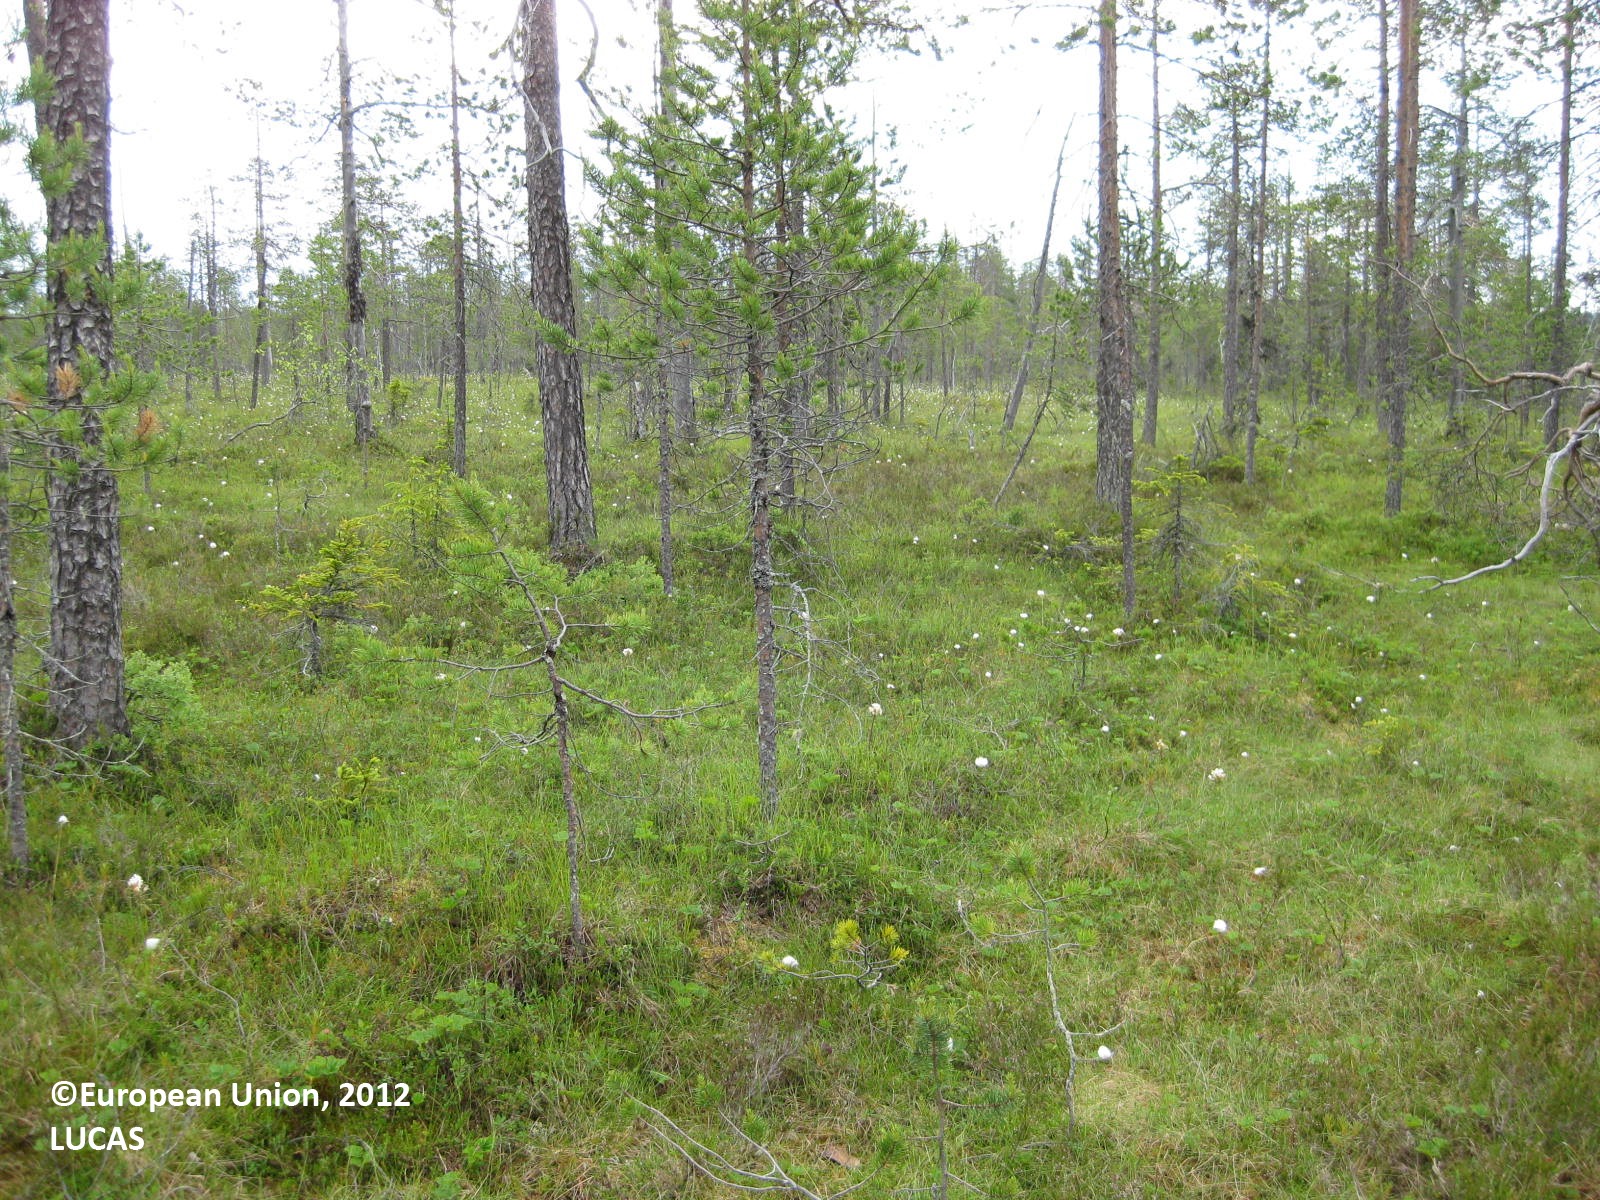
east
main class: Woodland
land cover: Pine dominated coniferous woodland
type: mire and swamp forests
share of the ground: 25 - 50 %
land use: Semi-natural and natural areas not in use
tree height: > 5 m
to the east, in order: Pine dominated coniferous woodland
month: July
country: FI
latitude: 65.5471
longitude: 29.2173
